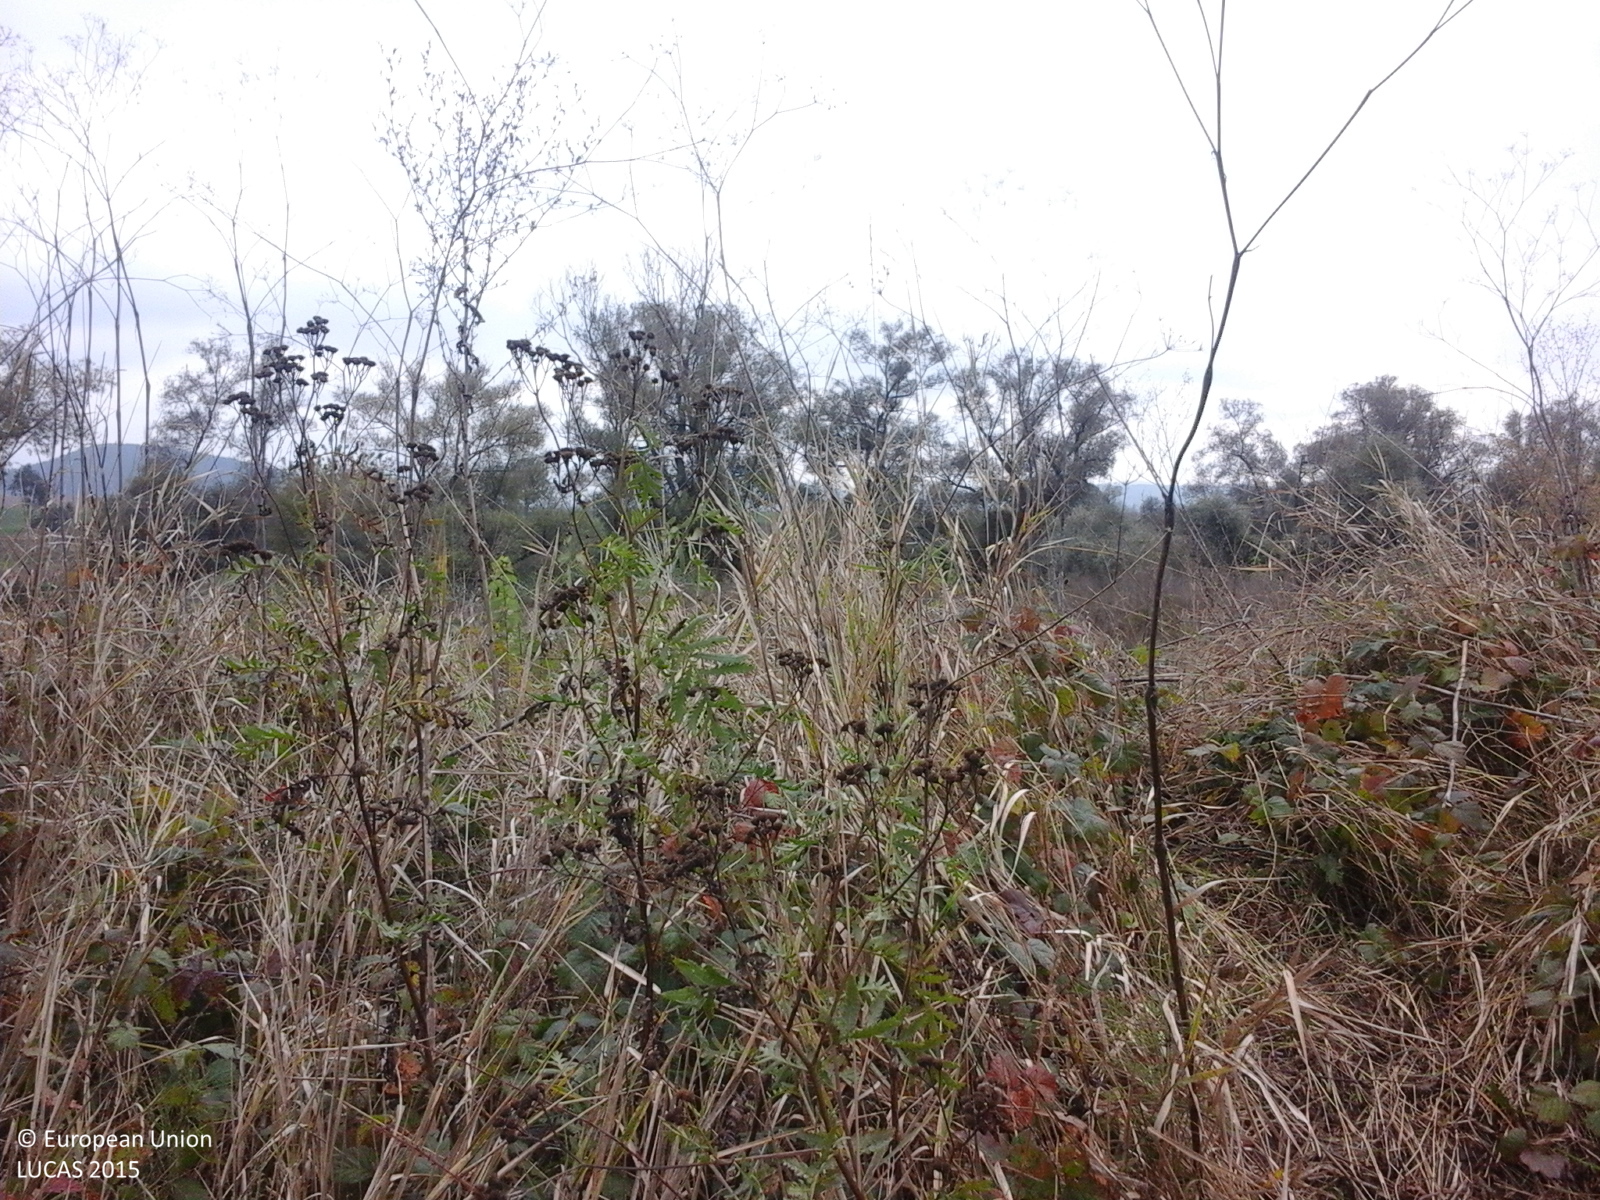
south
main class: Grassland
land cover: Spontaneously vegetated surfaces
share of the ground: > 75 %
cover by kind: herbaceous plants 100 %
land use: Fallow land
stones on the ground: < 10 %
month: October
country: RO
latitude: 46.0078
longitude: 25.3270
